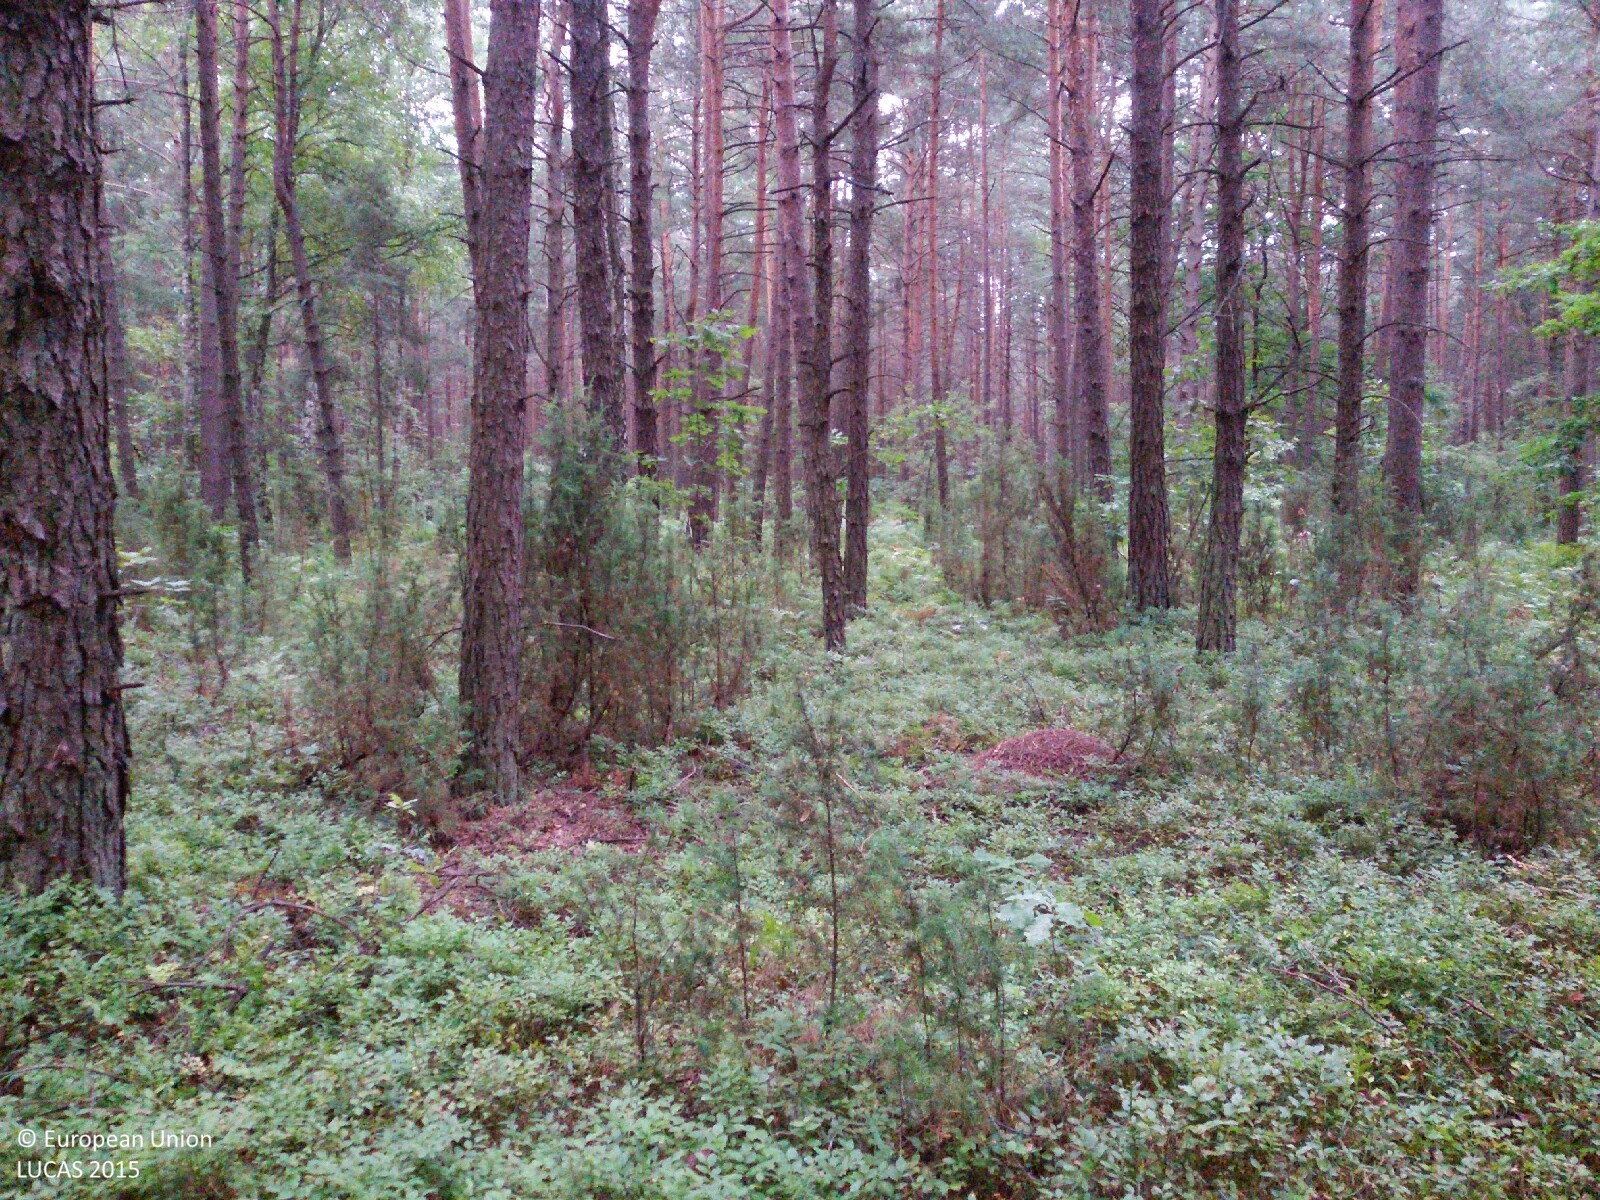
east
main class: Woodland
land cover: Pine dominated coniferous woodland
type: hemiboreal forest and nemoral coniferous forest and mixed broadleaved-coniferous forest
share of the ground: > 75 %
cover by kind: coniferous forest trees 85 %, herbaceous plants 10 %, shrubs 5 %
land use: Forestry
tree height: > 5 m
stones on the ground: < 10 %
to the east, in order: Pine dominated coniferous woodland; Tracks; Pine dominated coniferous woodland
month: July
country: PL
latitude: 51.8853
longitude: 21.7208
